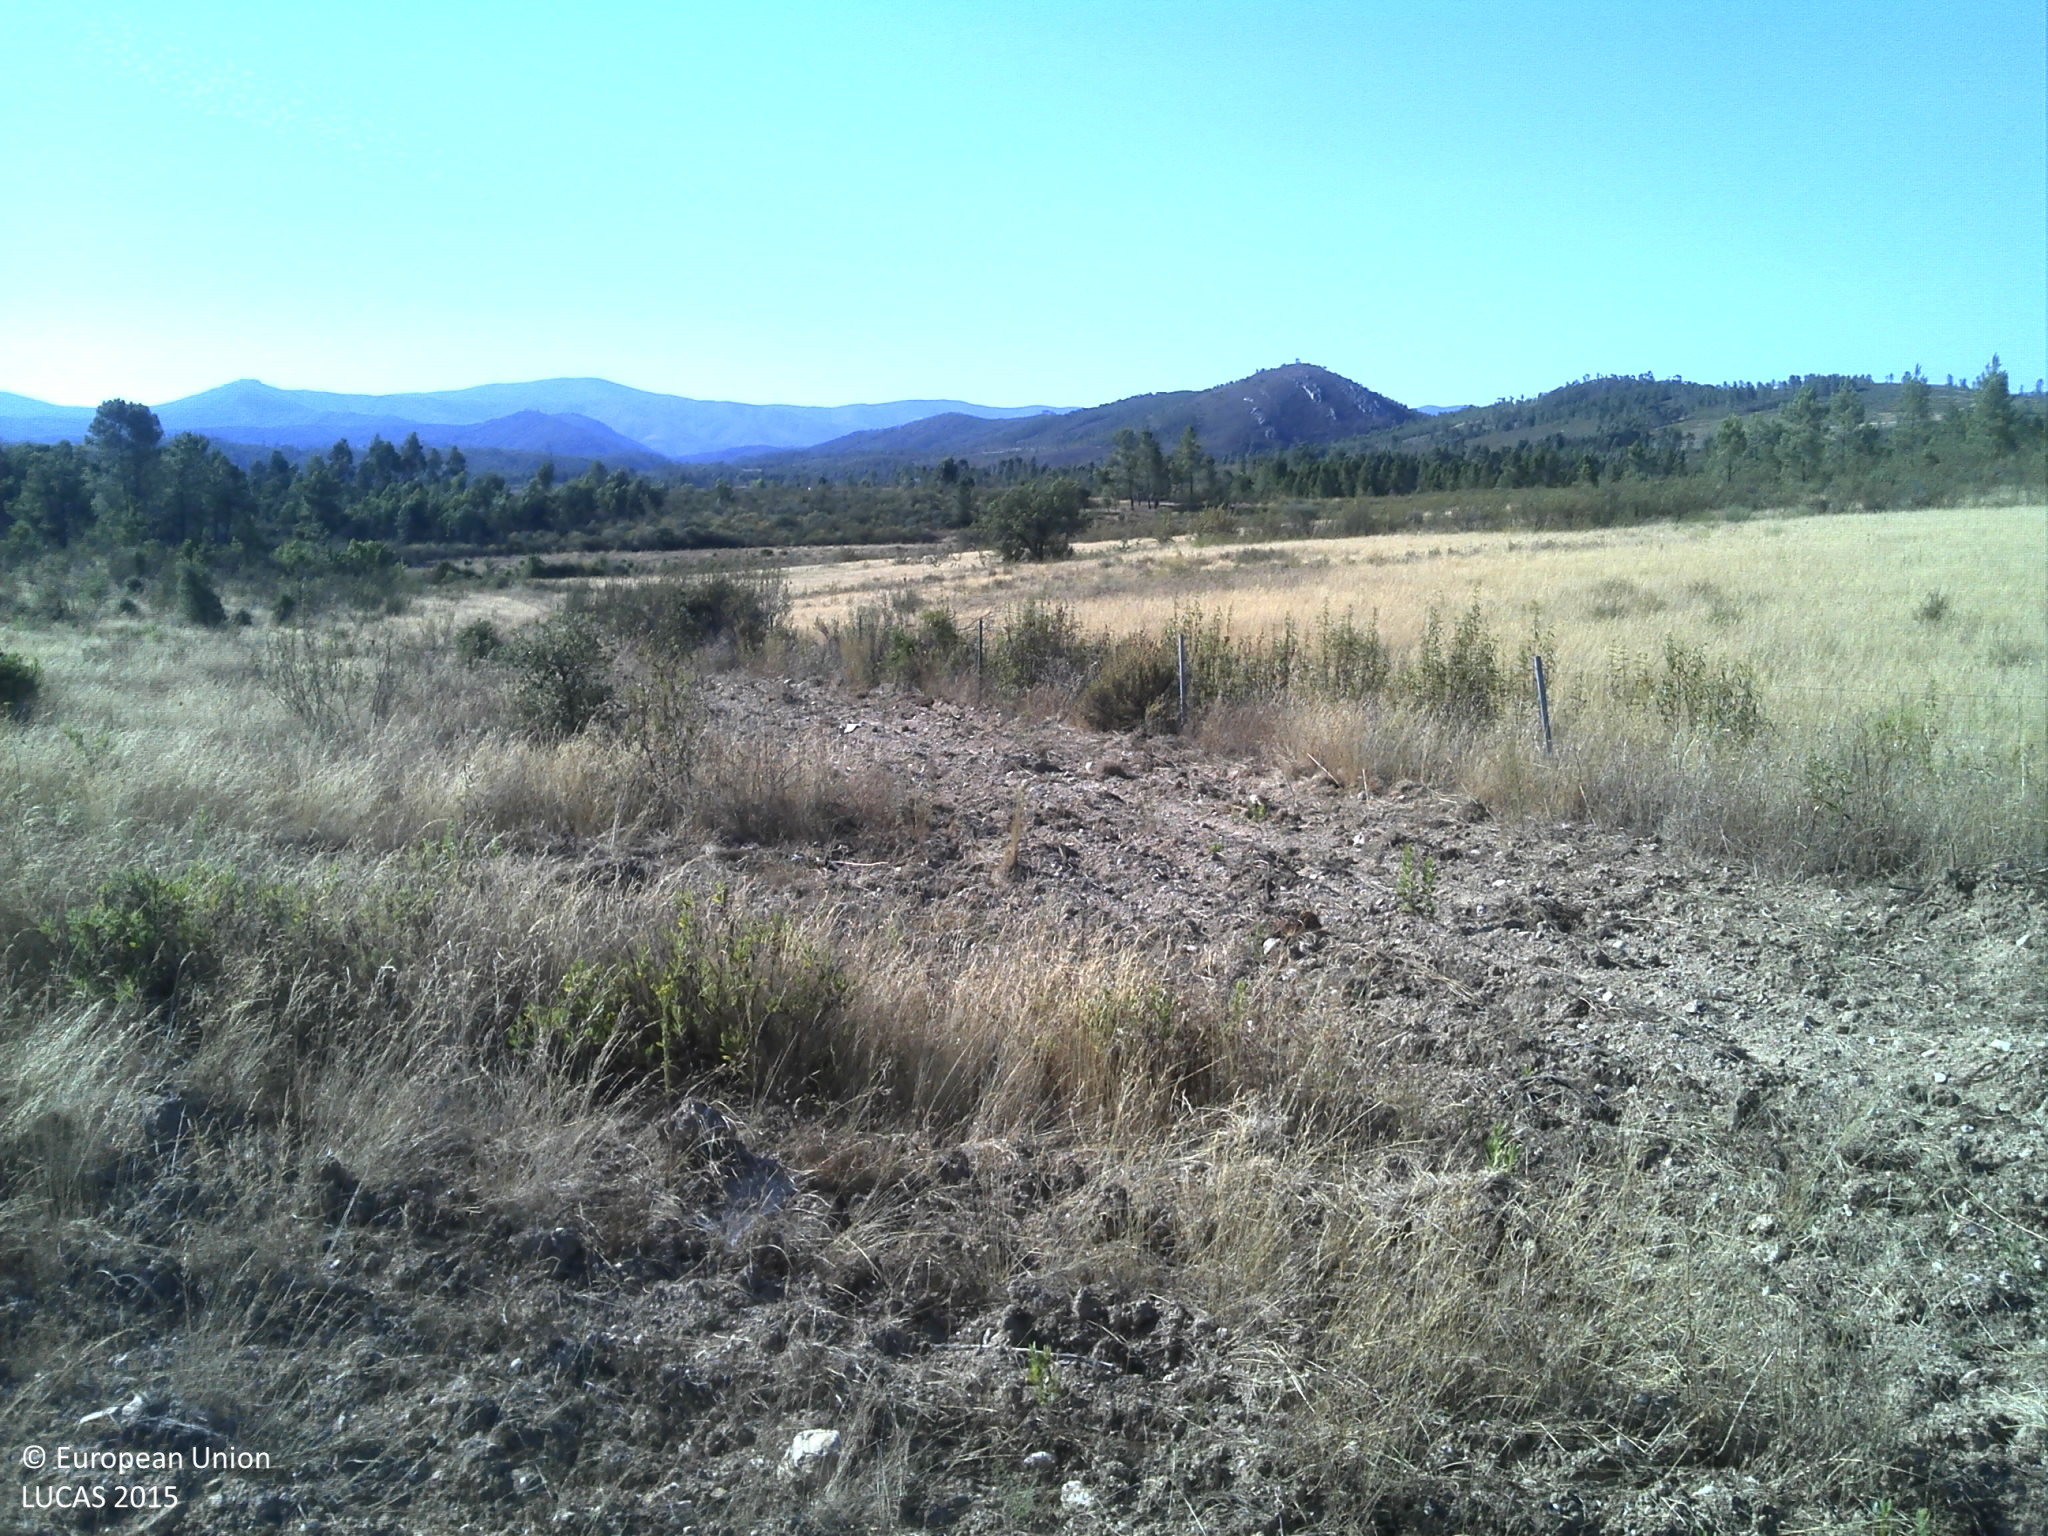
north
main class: Grassland
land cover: Grassland with sparse tree/shrub cover
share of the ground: 25 - 50 %
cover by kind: unconsolidated bare surface 70 %, herbaceous plants 25 %, broadleaved forest trees 5 %
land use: Forestry
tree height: < 5 m
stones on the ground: 10 - 25 %
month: July
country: PT
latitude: 39.9012
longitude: -7.5889
